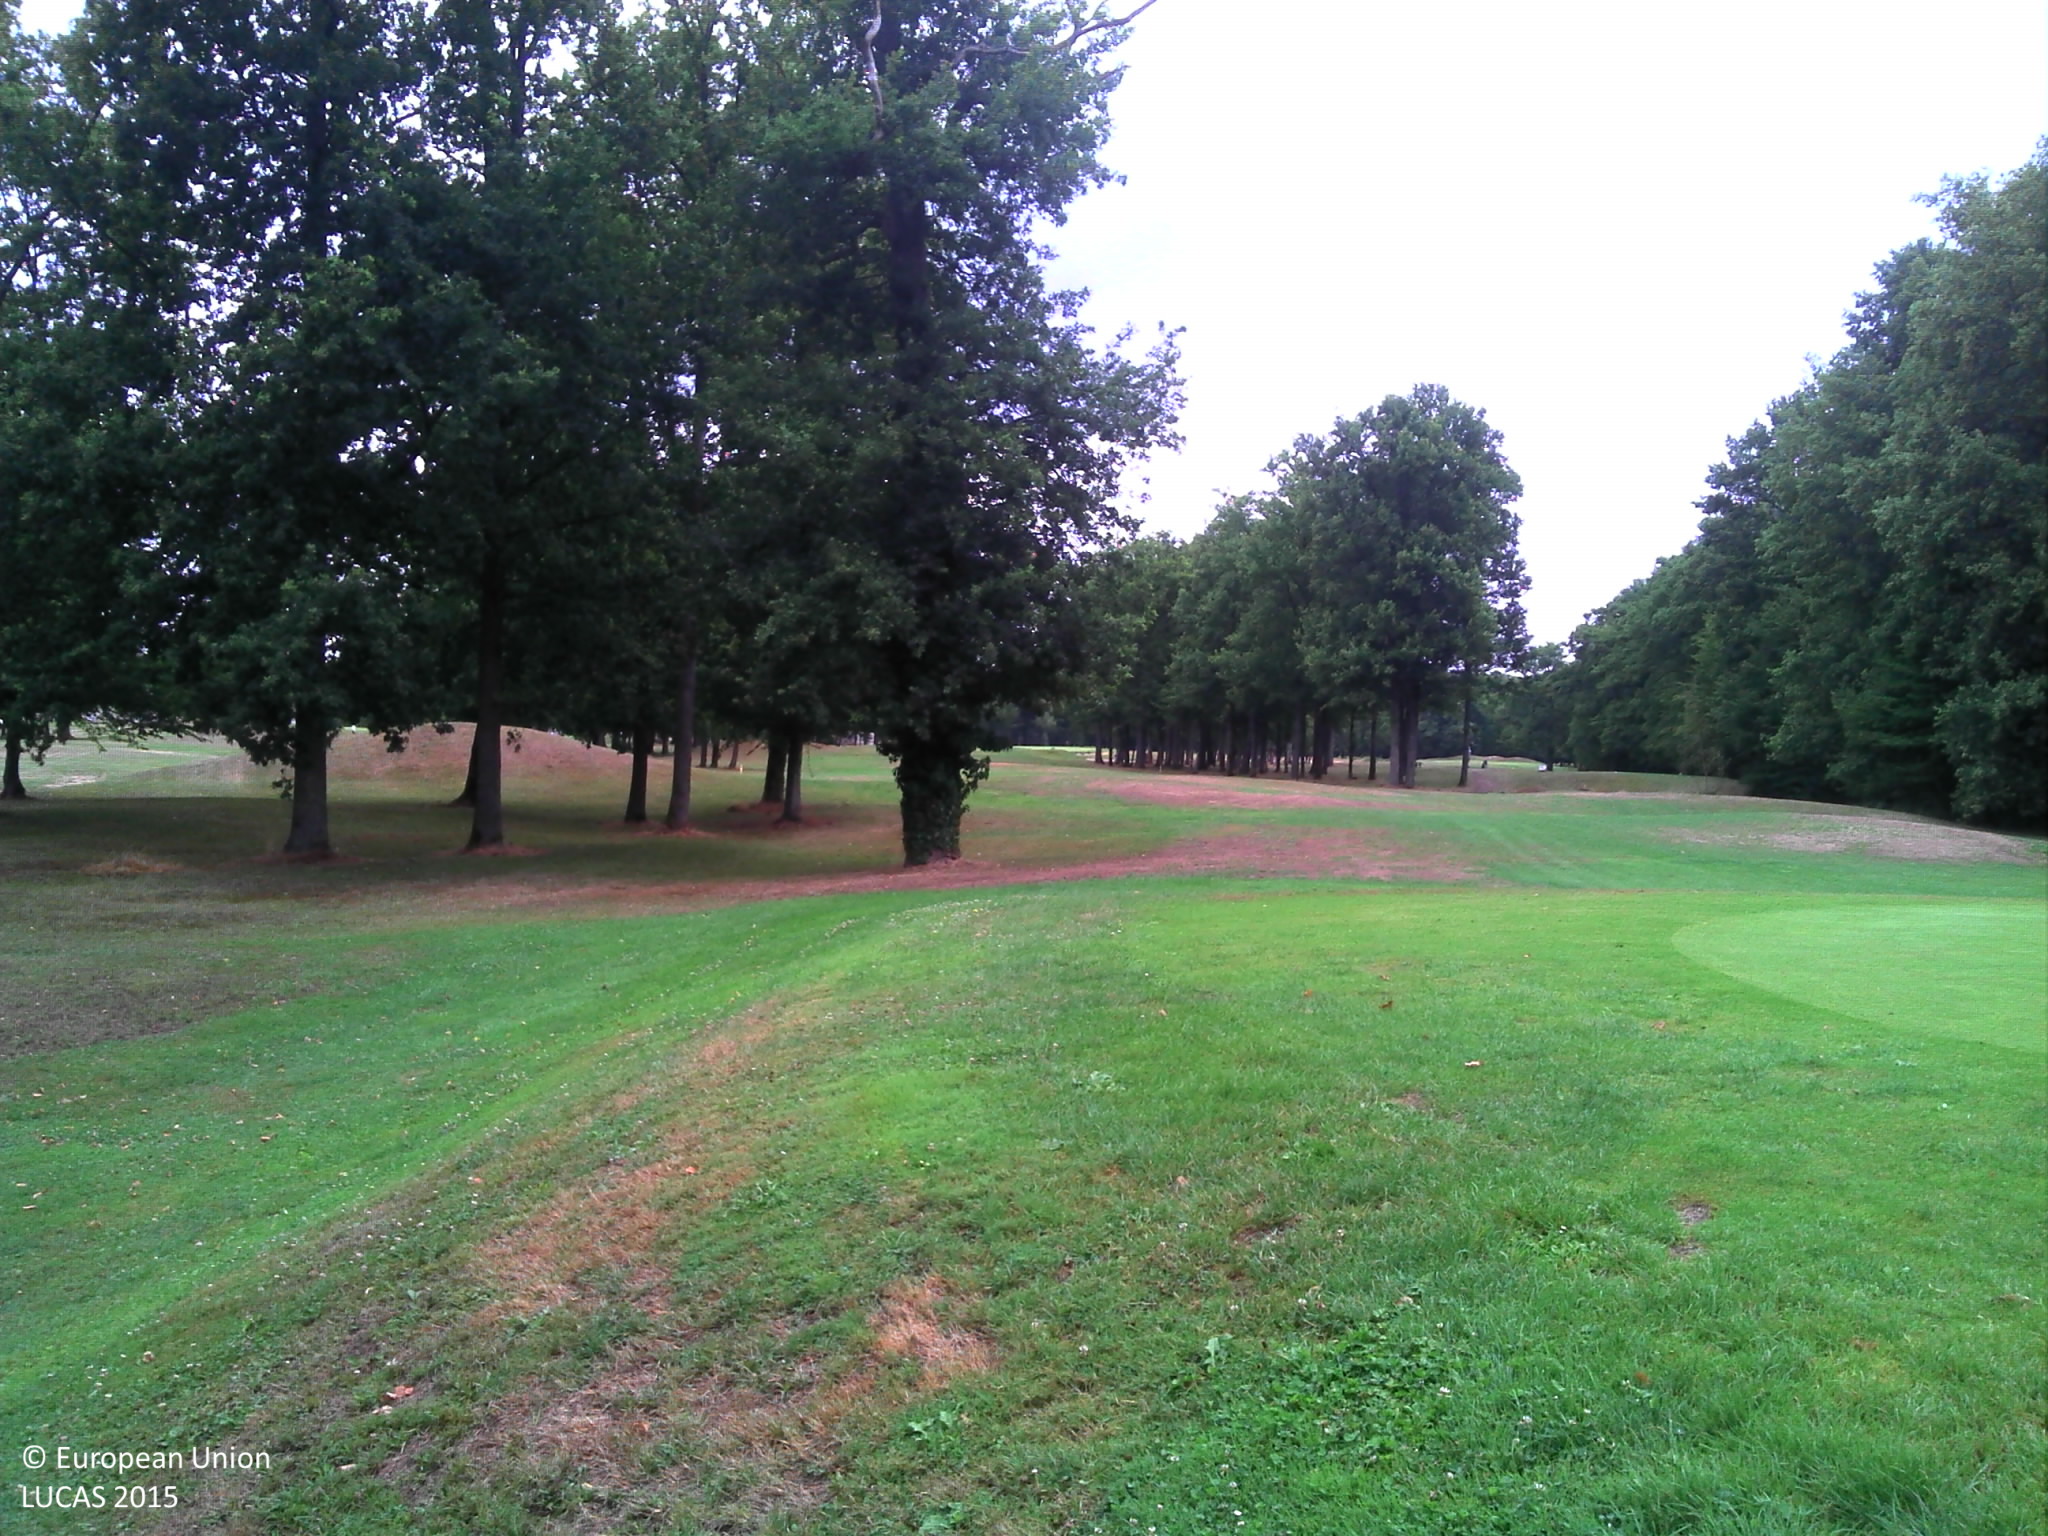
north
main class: Grassland
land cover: Grassland without tree/shrub cover
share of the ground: > 75 %
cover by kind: herbaceous plants 70 %, lichens and mosses 5 %
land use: Sport
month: July
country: FR
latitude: 48.7411
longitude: 2.7149
